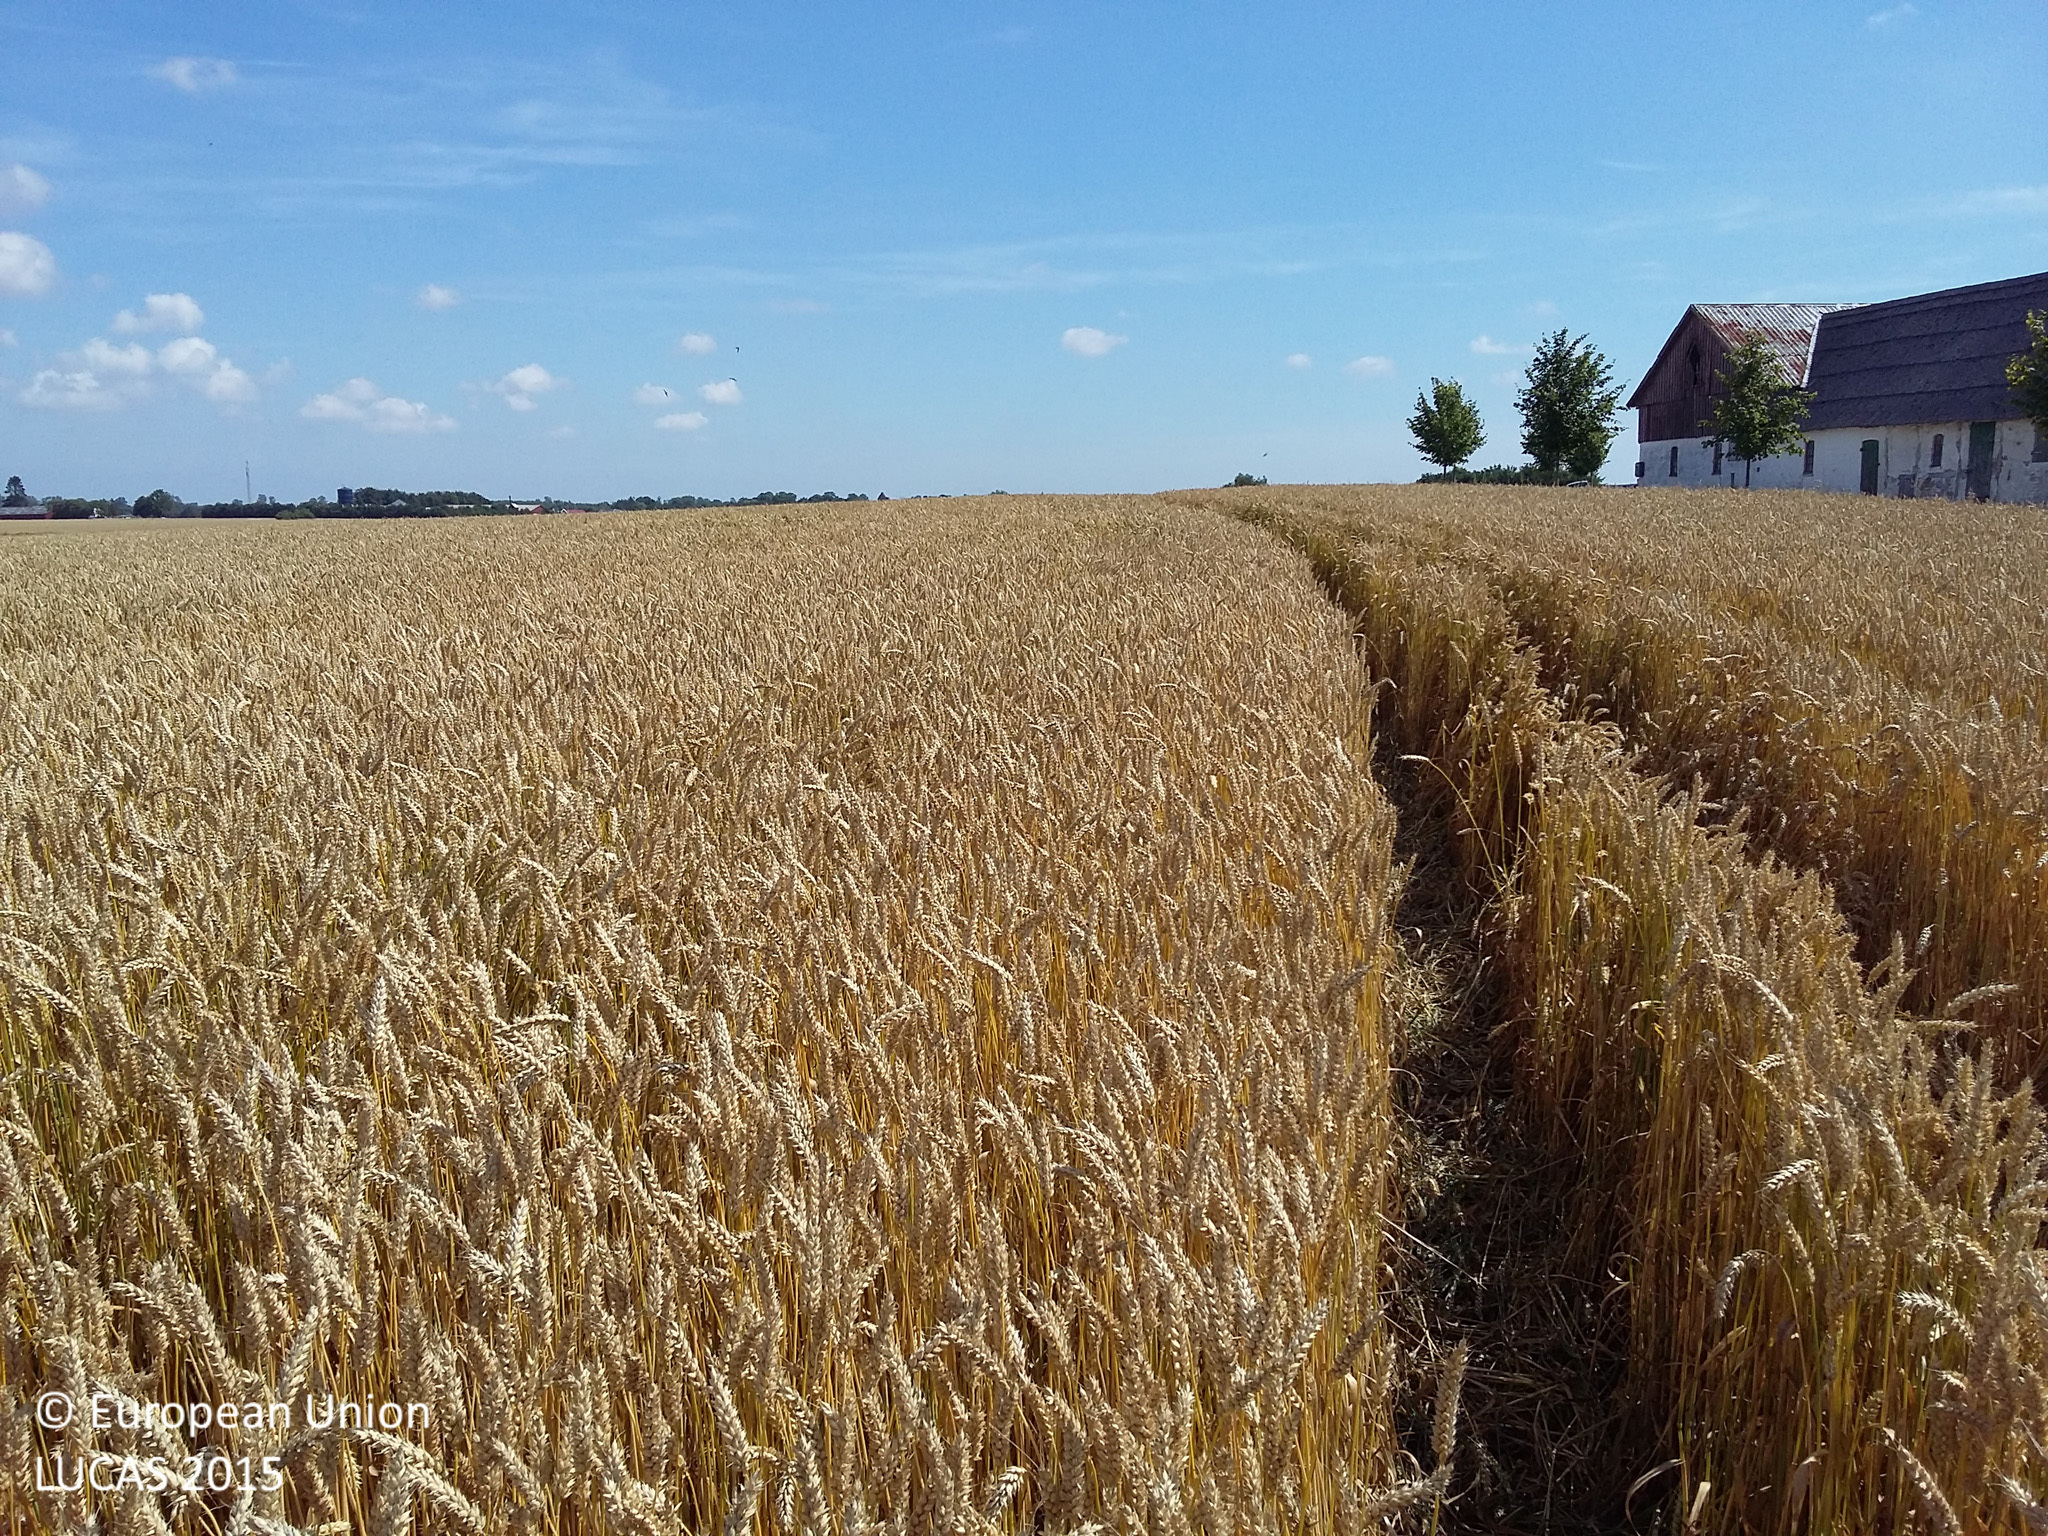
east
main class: Cropland
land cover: Common wheat
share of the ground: > 75 %
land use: Agriculture (excluding fallow land and kitchen gardens)
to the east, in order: Common wheat
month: August
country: DK
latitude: 55.3825
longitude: 11.9083
